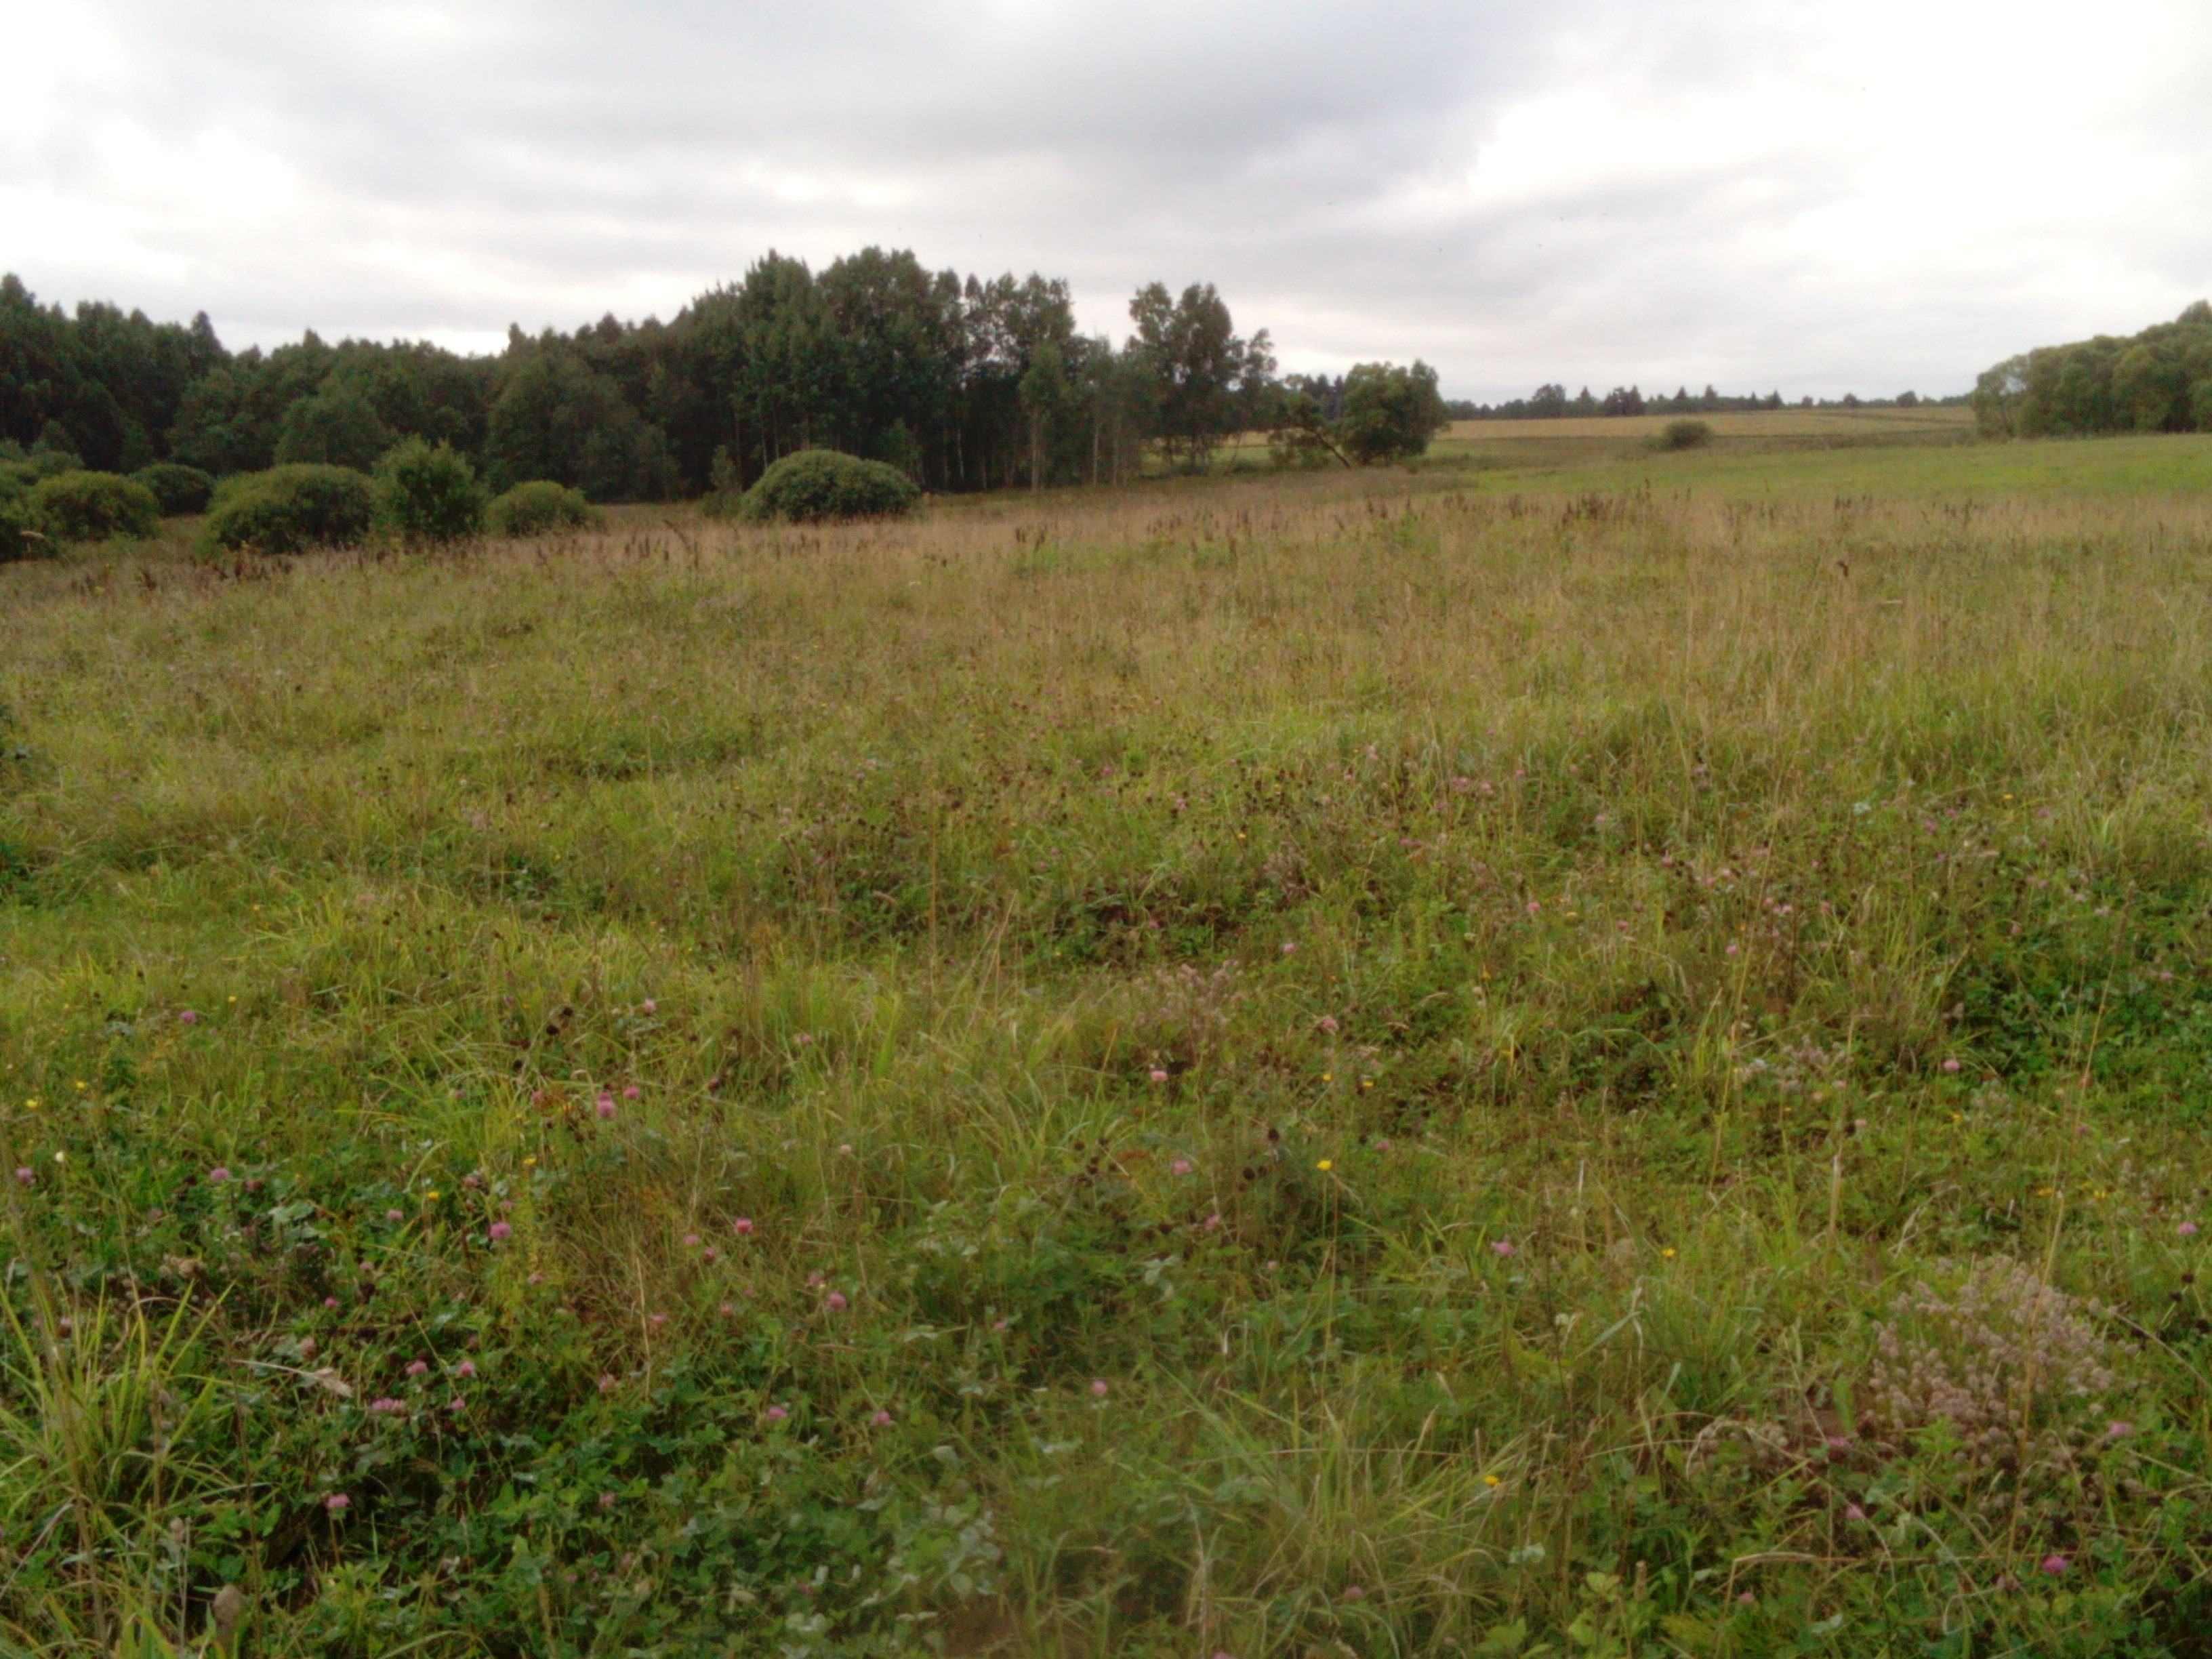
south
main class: Grassland
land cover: Grassland without tree/shrub cover
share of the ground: > 75 %
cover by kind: herbaceous plants 100 %
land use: Agriculture (excluding fallow land and kitchen gardens)
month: September
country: LT
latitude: 55.9450
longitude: 22.7939
